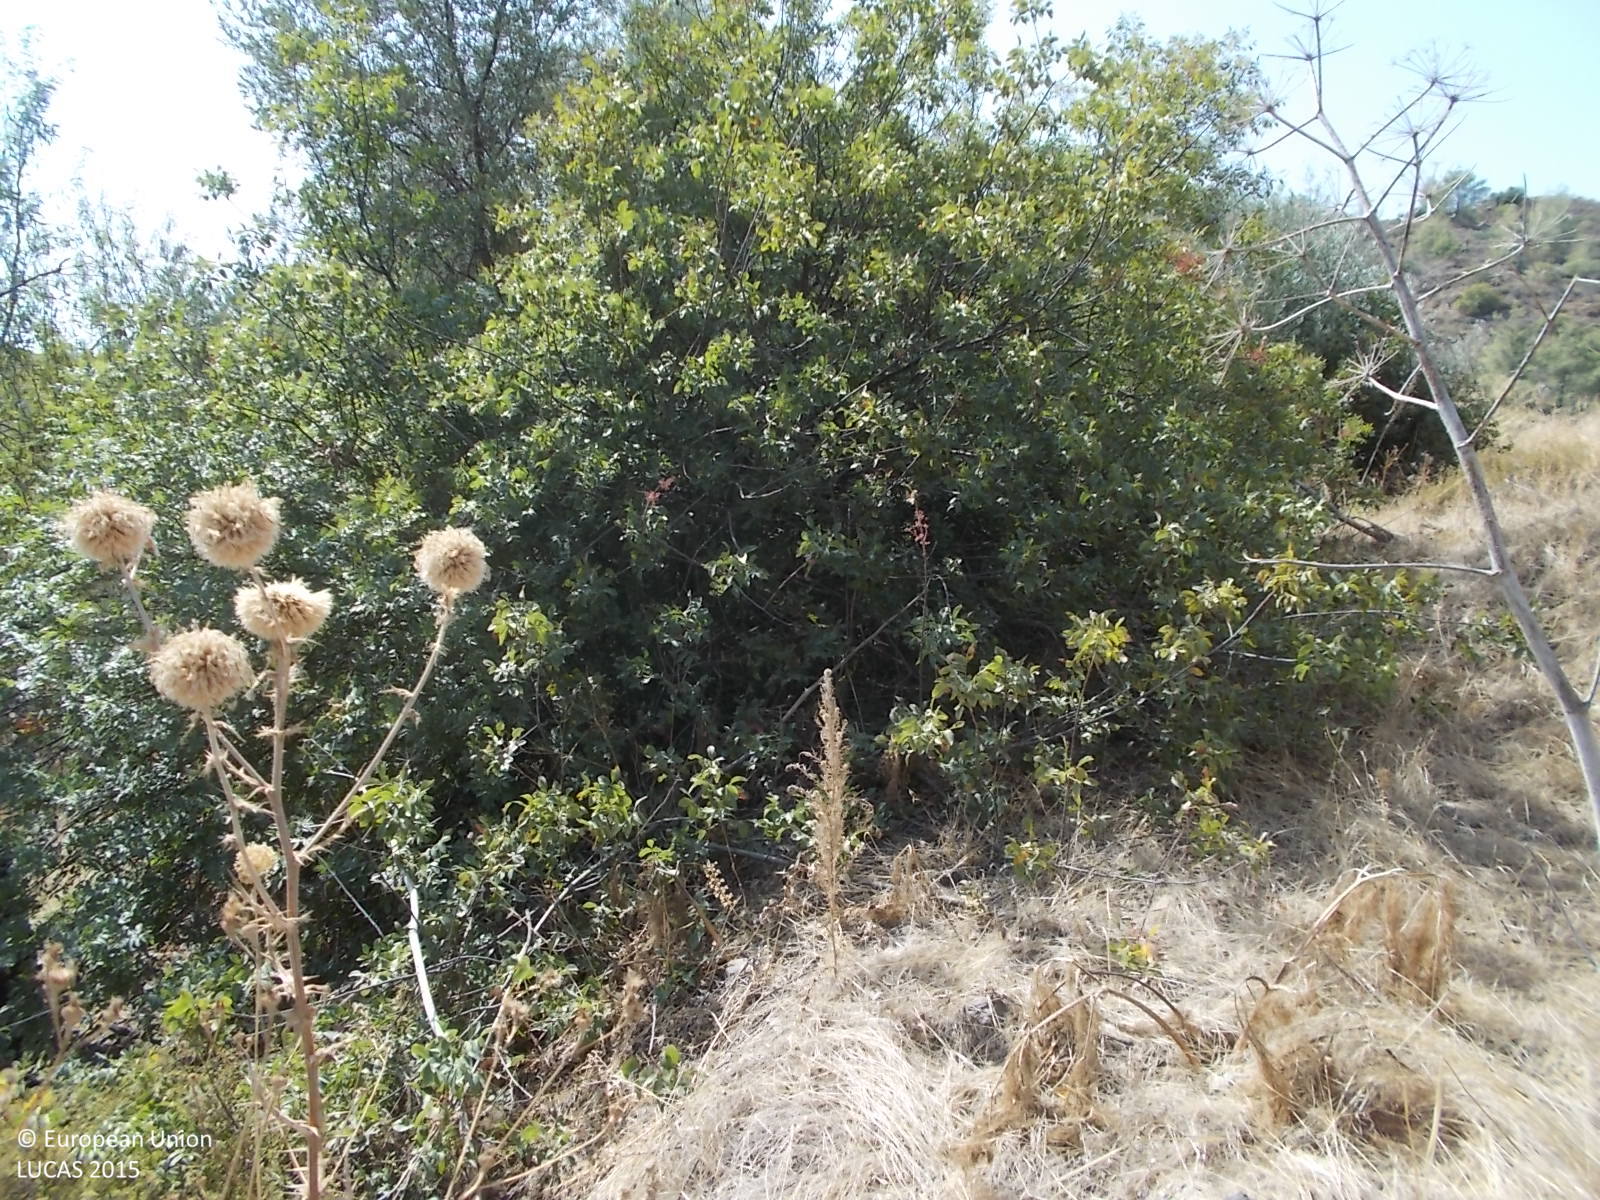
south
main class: Cropland
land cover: Nuts trees
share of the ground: 25 - 50 %
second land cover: Spontaneously vegetated surfaces
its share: > 75 %
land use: Abandoned areas
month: April
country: CY
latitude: 34.8659
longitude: 33.1583
